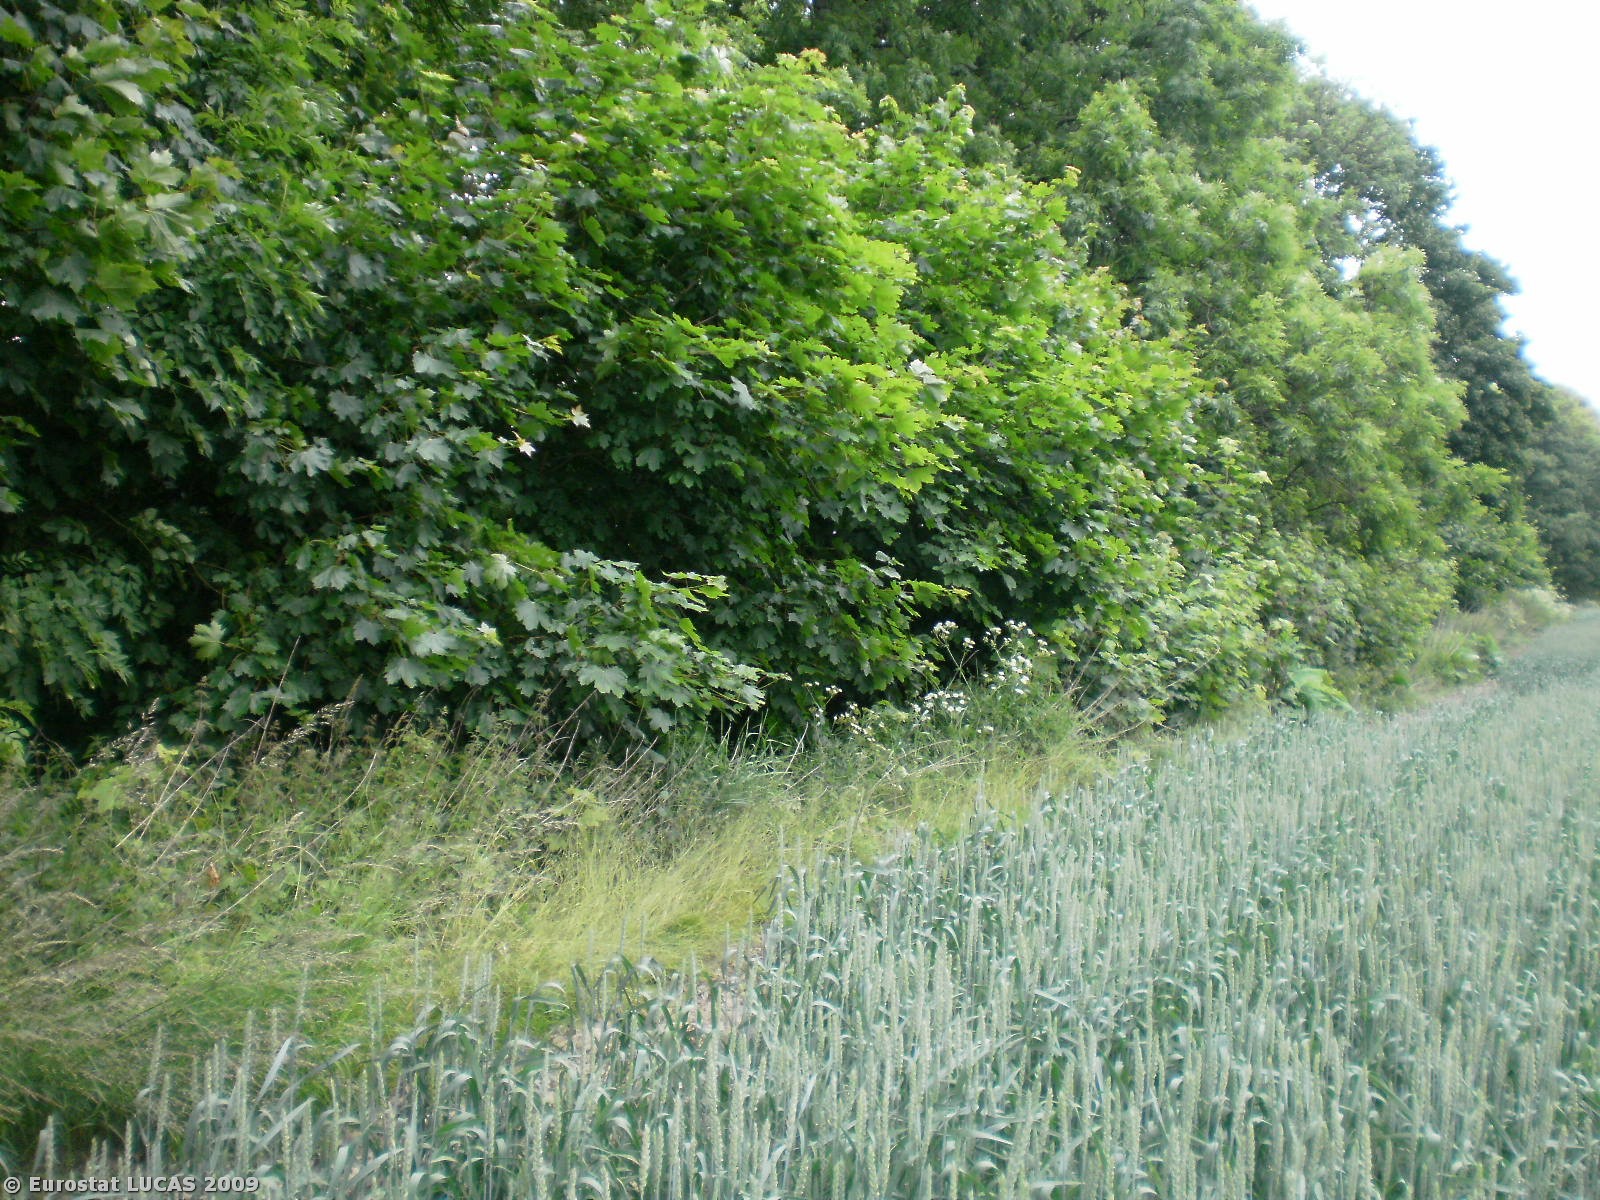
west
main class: Cropland
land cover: Common wheat
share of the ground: > 75 %
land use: Agriculture (excluding fallow land and kitchen gardens)
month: June
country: PL
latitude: 54.7145
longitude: 17.9137
